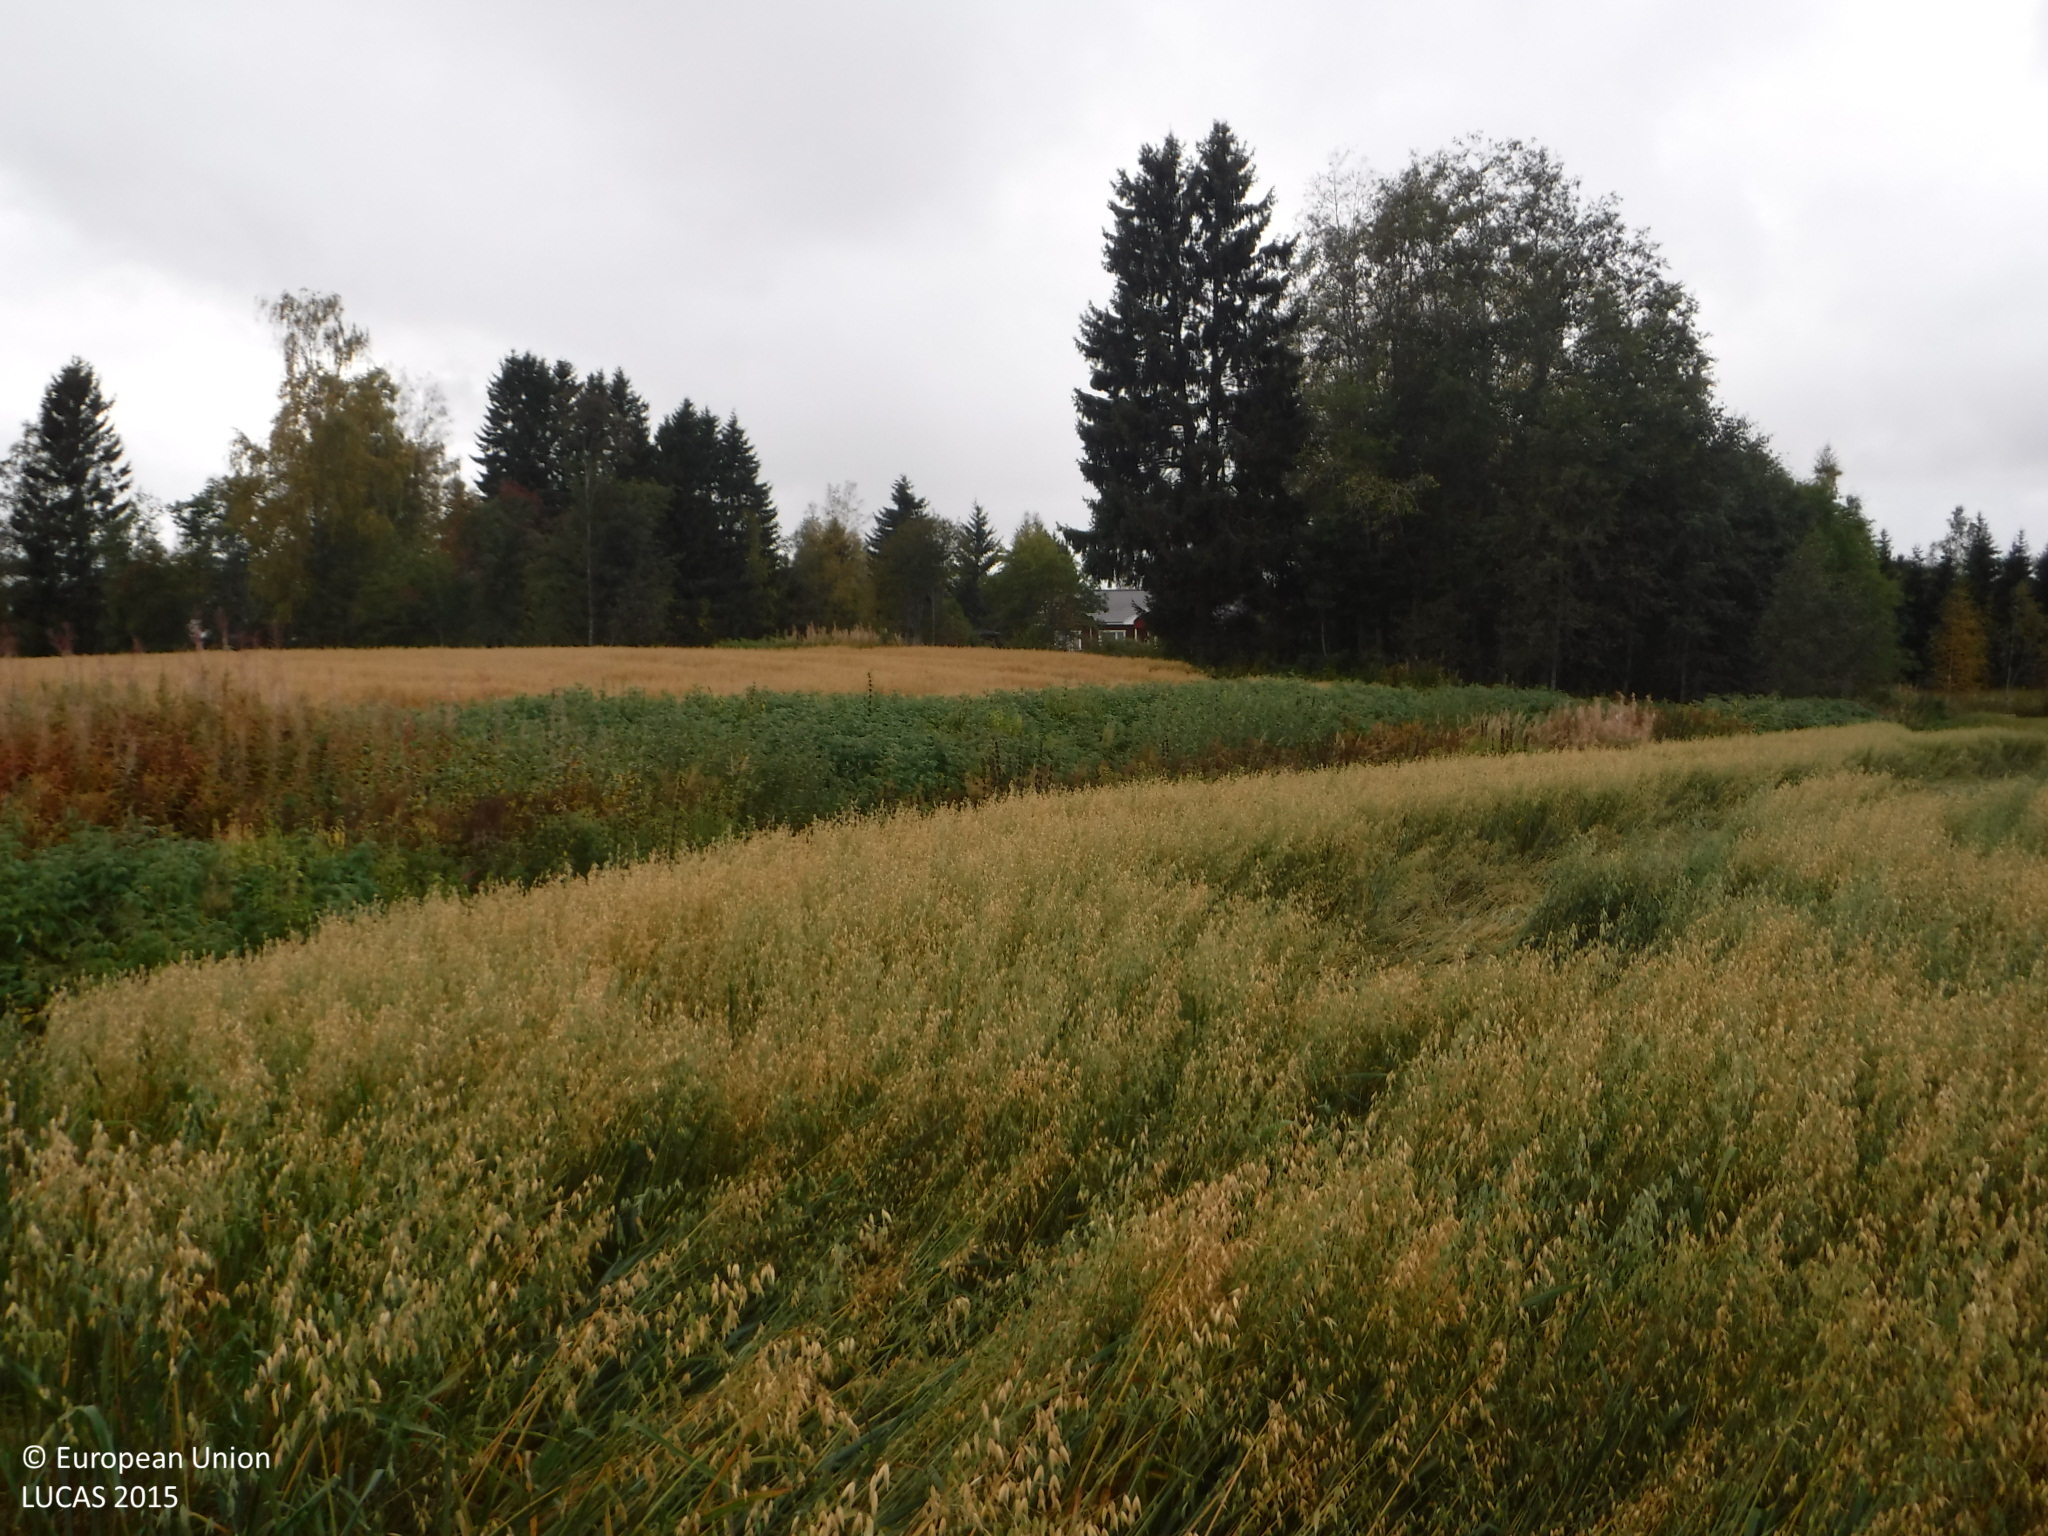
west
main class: Cropland
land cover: Oats
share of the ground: > 75 %
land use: Agriculture (excluding fallow land and kitchen gardens)
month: September
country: FI
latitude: 61.9997
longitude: 22.2572
